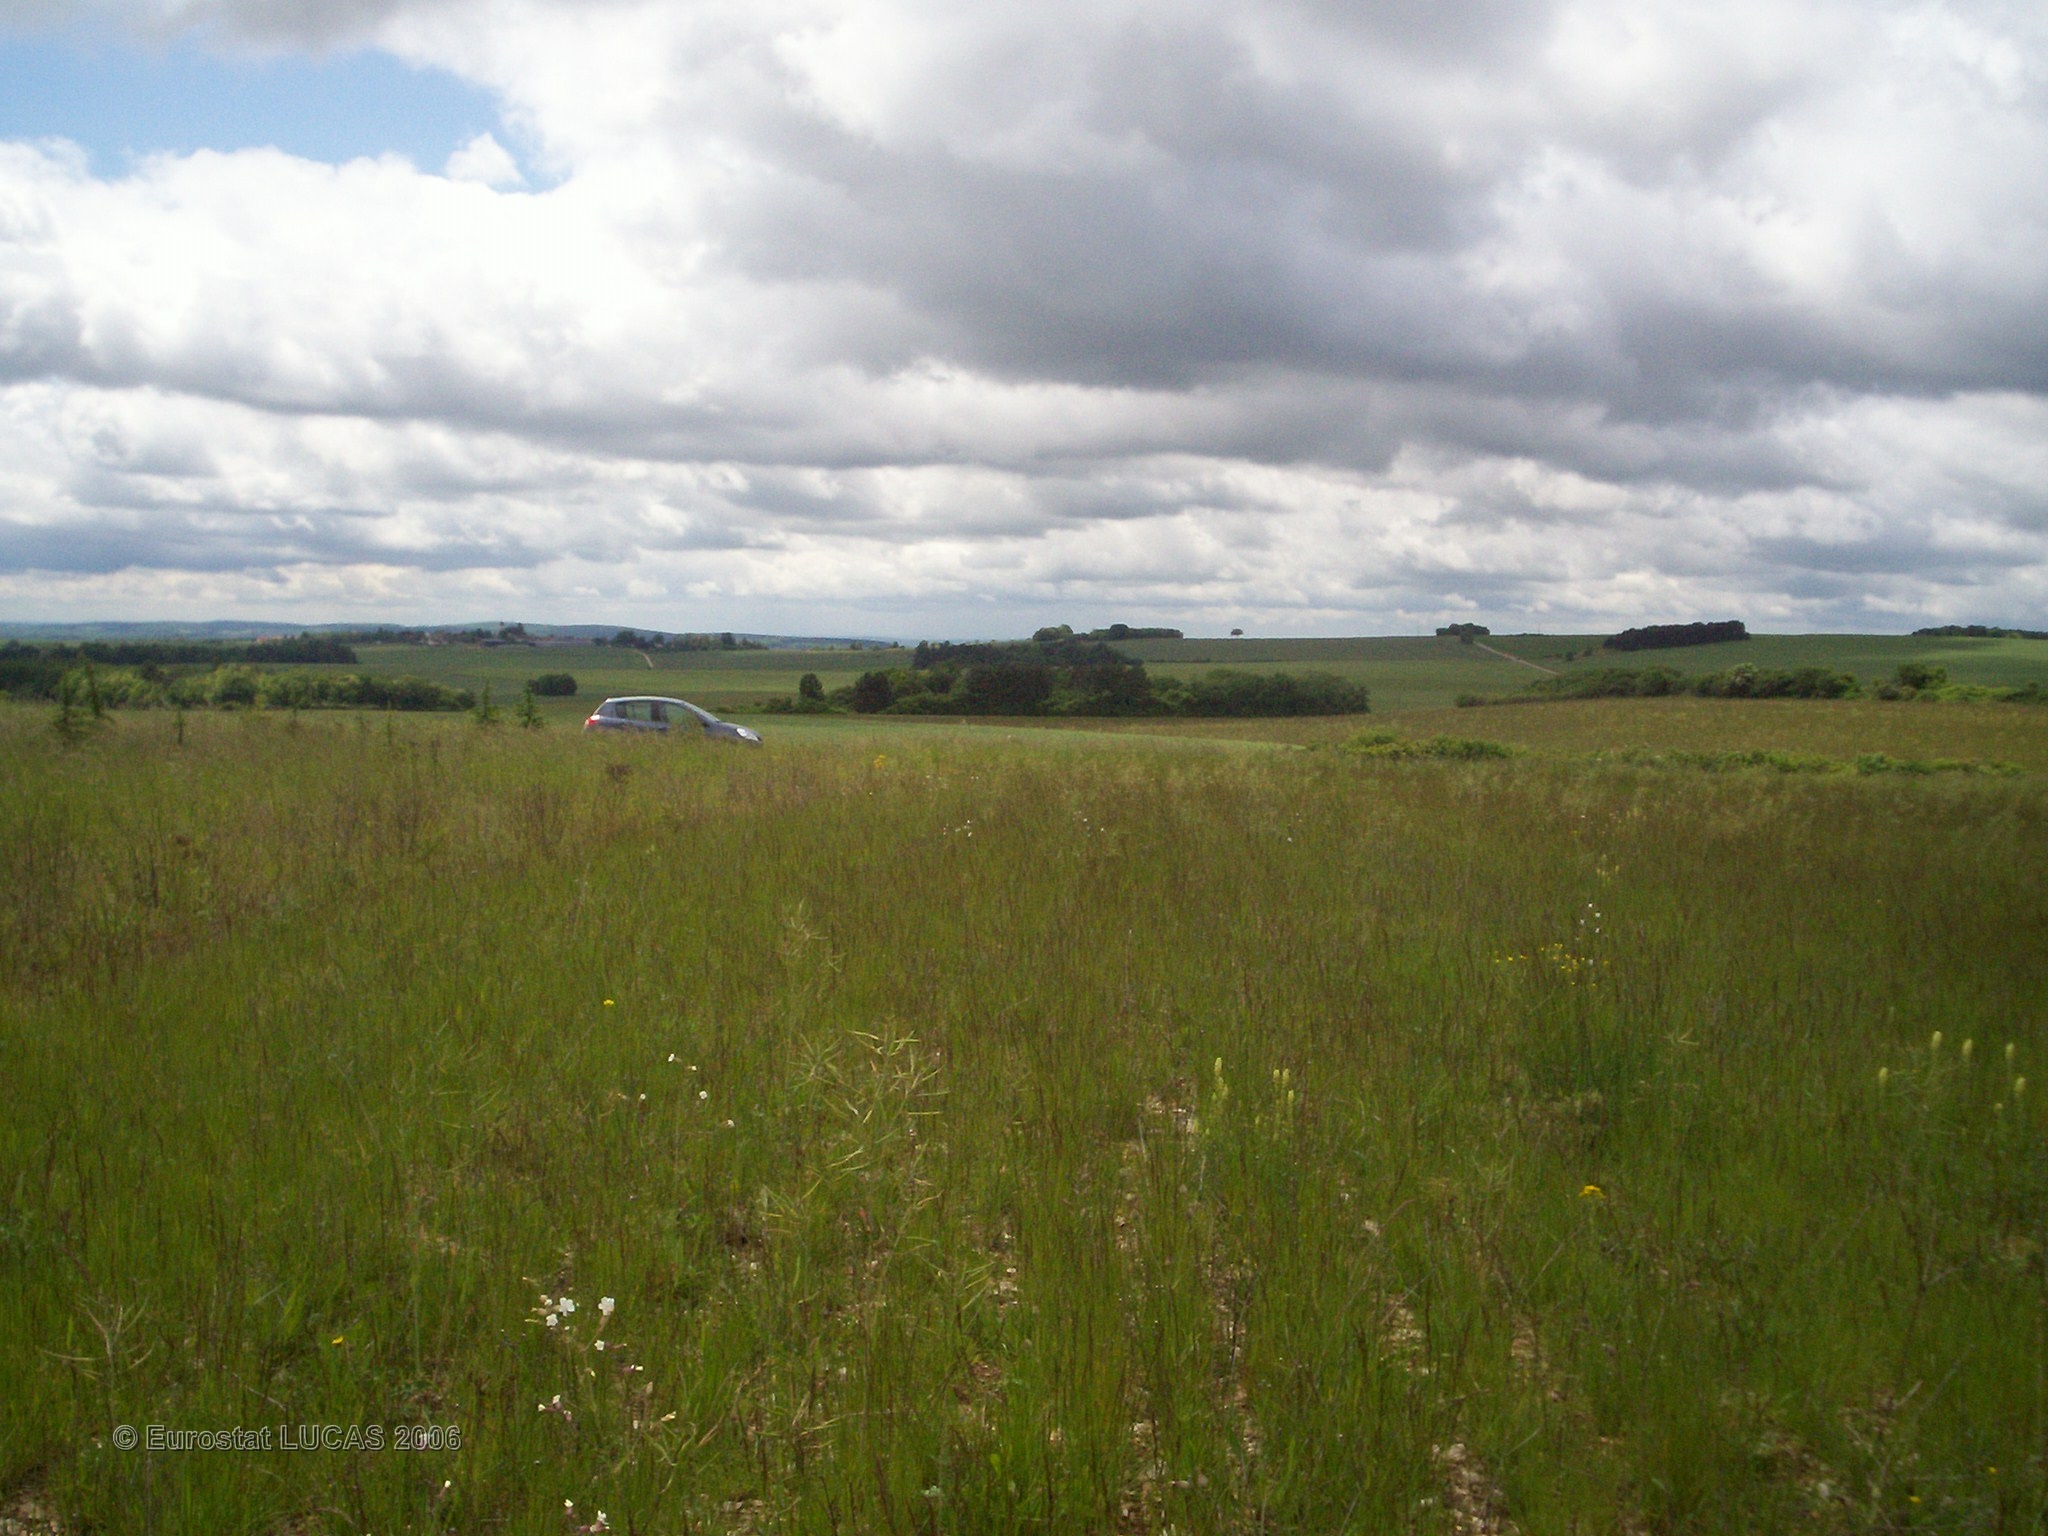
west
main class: Grassland
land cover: Grassland without tree/shrub cover
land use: Agriculture (excluding fallow land and kitchen gardens)
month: May
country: FR
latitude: 47.6015
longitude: 3.8655
